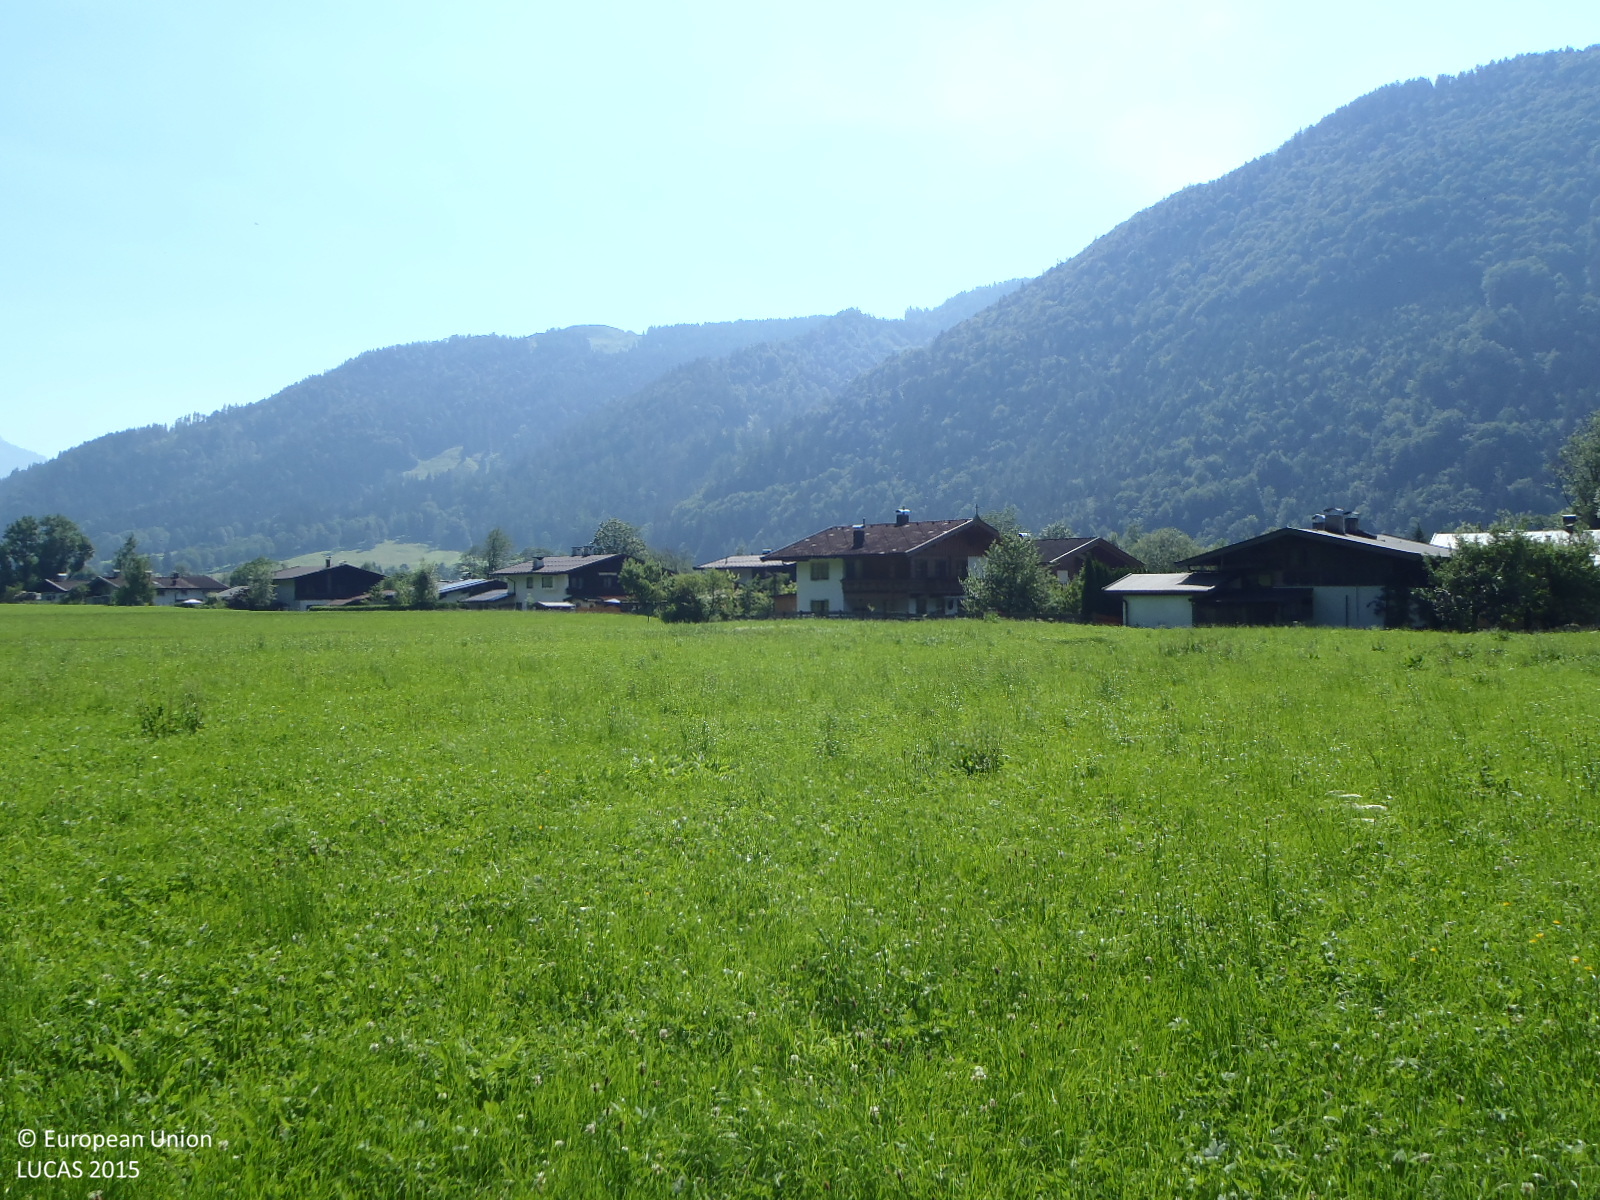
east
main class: Grassland
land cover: Grassland without tree/shrub cover
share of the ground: > 75 %
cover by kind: herbaceous plants 100 %
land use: Agriculture (excluding fallow land and kitchen gardens)
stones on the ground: < 10 %
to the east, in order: Grassland without tree/shrub cover; Ditches and canals; Fences; Grassland without tree/shrub cover; Artificial constructions in urban areas; Grass margins; Broadleaved woodland; Rivers and streams; Fences; Grassland without tree/shrub cover; Fences; Grassland without tree/shrub cover
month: July
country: AT
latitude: 47.5660
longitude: 12.4574
